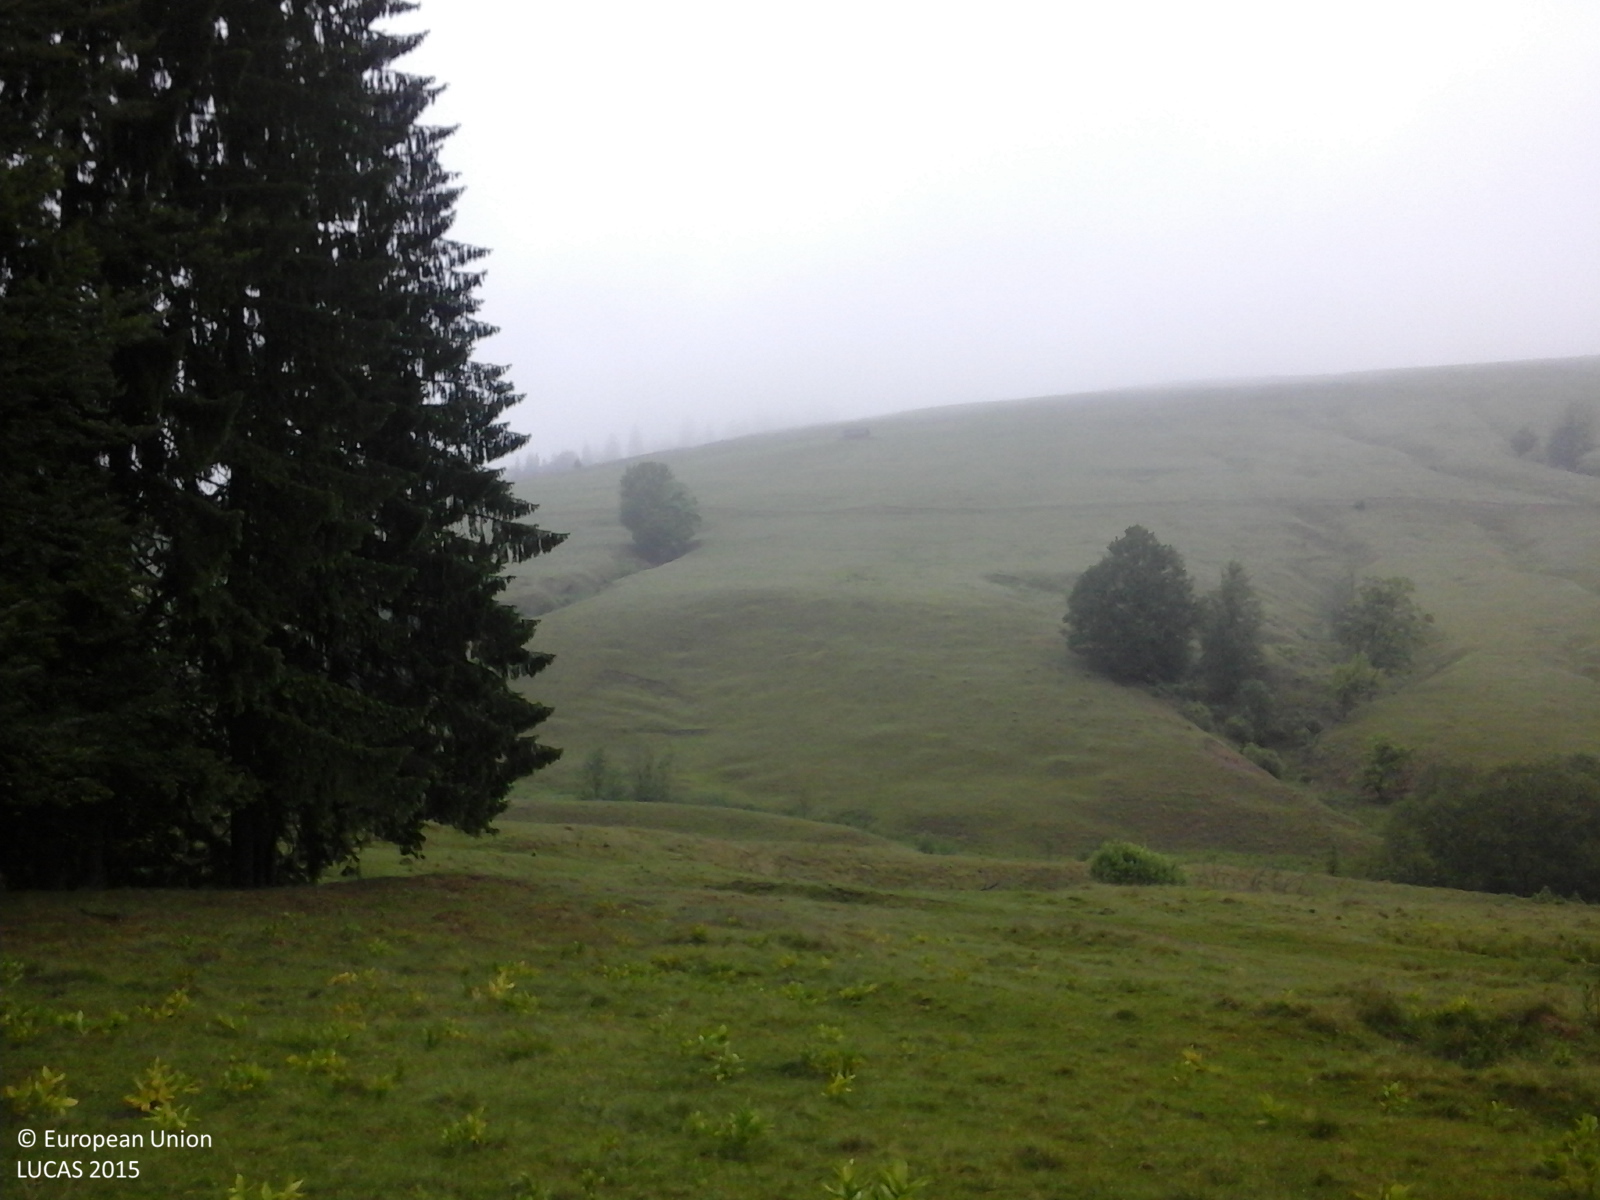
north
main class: Grassland
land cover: Grassland without tree/shrub cover
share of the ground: > 75 %
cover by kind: herbaceous plants 100 %
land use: Agriculture (excluding fallow land and kitchen gardens)
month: June
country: RO
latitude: 47.3270
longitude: 25.8293
